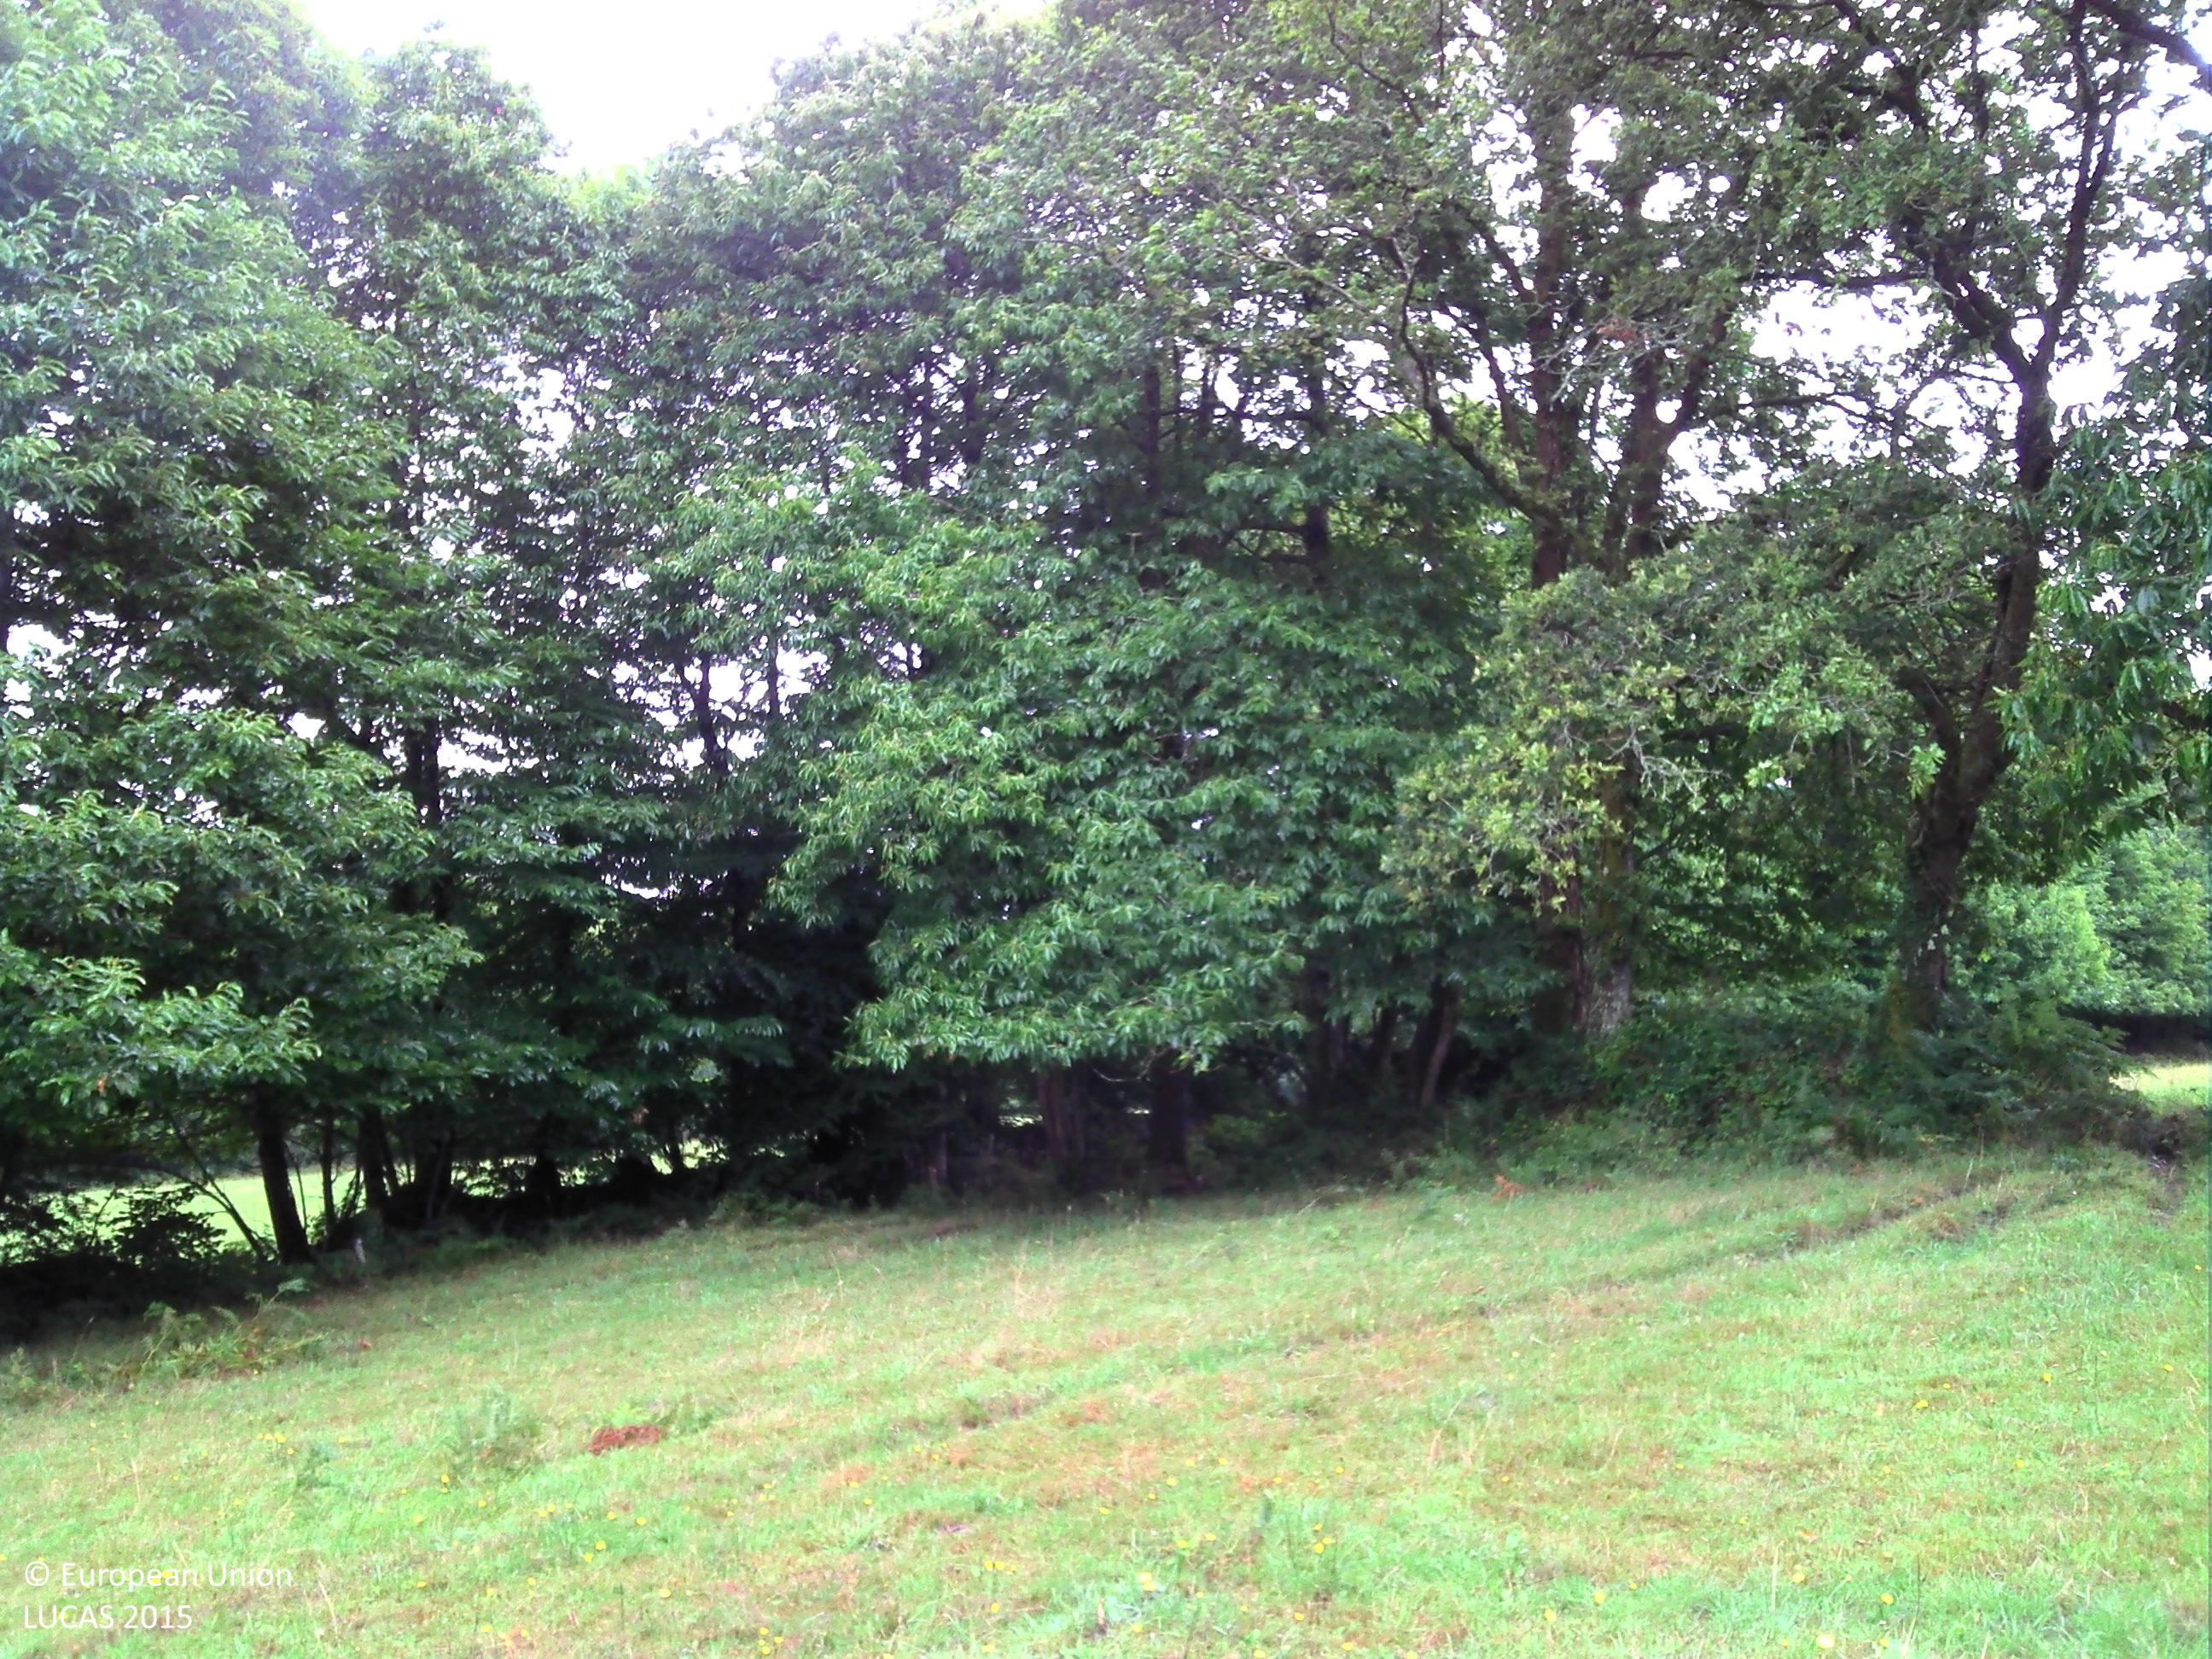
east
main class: Grassland
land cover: Grassland without tree/shrub cover
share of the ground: > 75 %
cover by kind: herbaceous plants 70 %, consolidated bare surface 20 %, shrubs 5 %, unconsolidated bare surface 5 %
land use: Agriculture (excluding fallow land and kitchen gardens)
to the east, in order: Grassland without tree/shrub cover; Fences; Broadleaved woodland; Fences; Grassland without tree/shrub cover; Fences; Broadleaved woodland; Rivers and streams; Broadleaved woodland
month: July
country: FR
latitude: 48.0237
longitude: -3.5262
